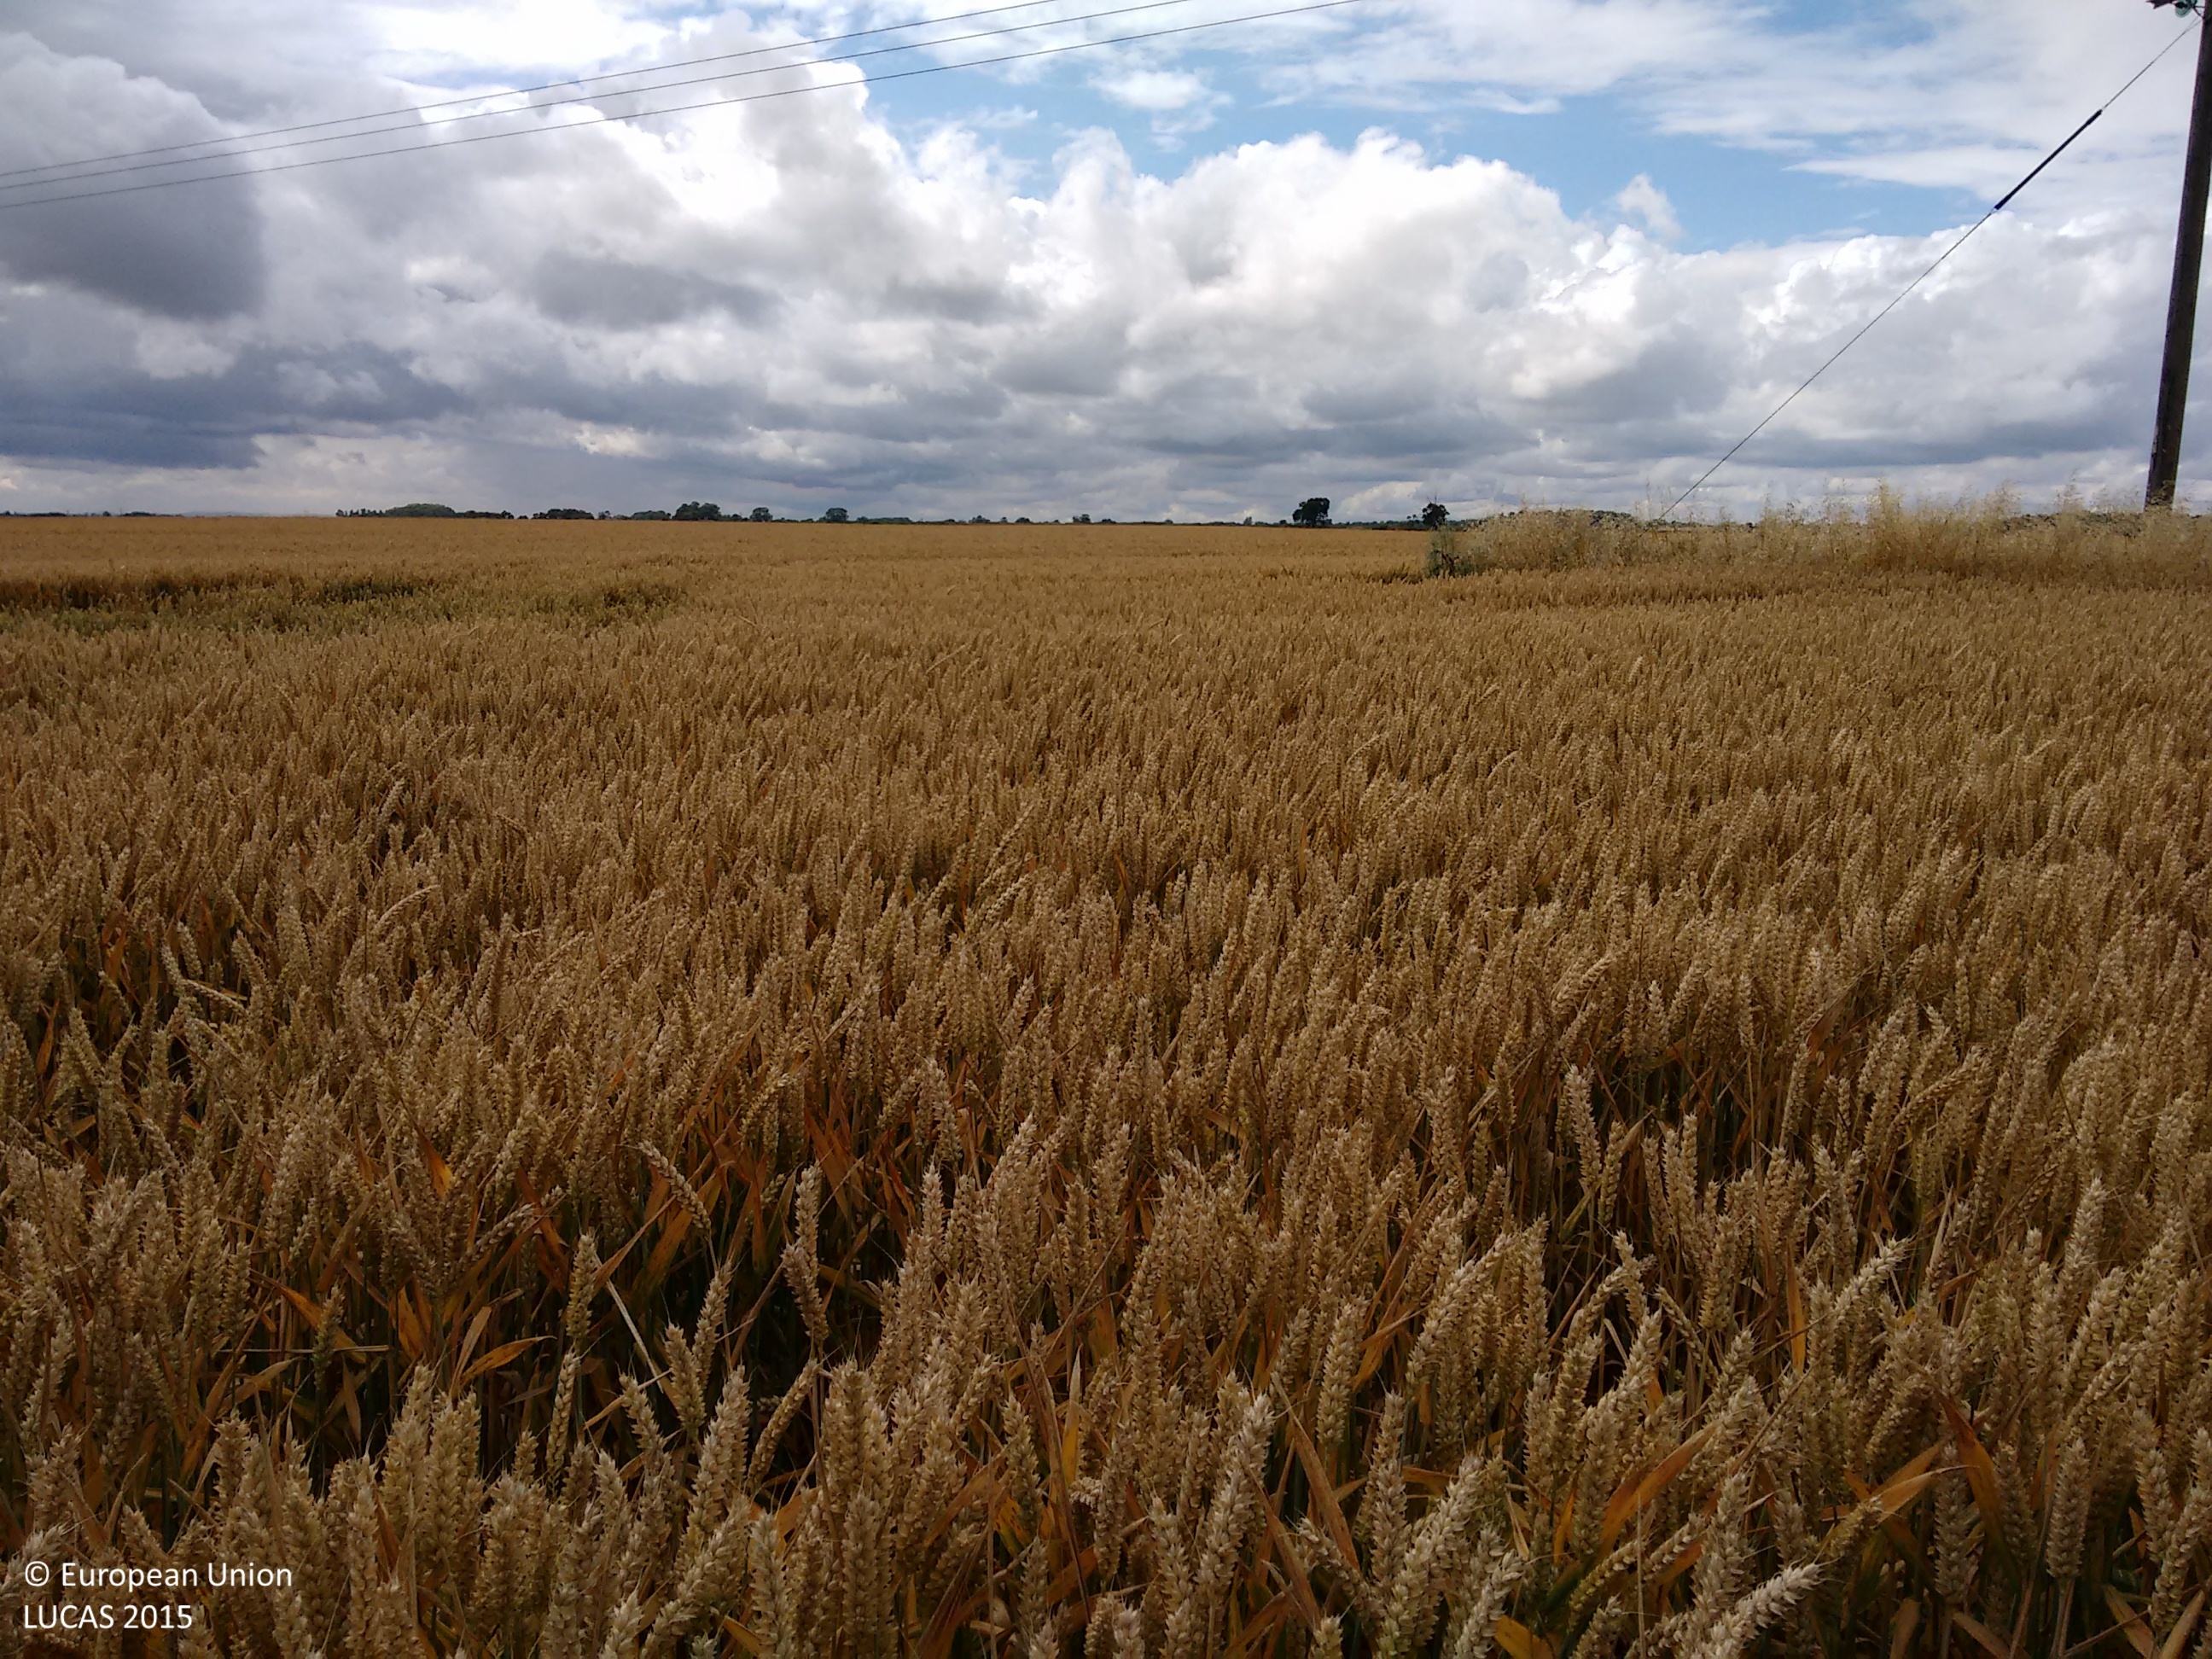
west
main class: Cropland
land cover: Common wheat
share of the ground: > 75 %
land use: Agriculture (excluding fallow land and kitchen gardens)
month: July
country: GB
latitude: 52.7733
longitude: -0.7880
